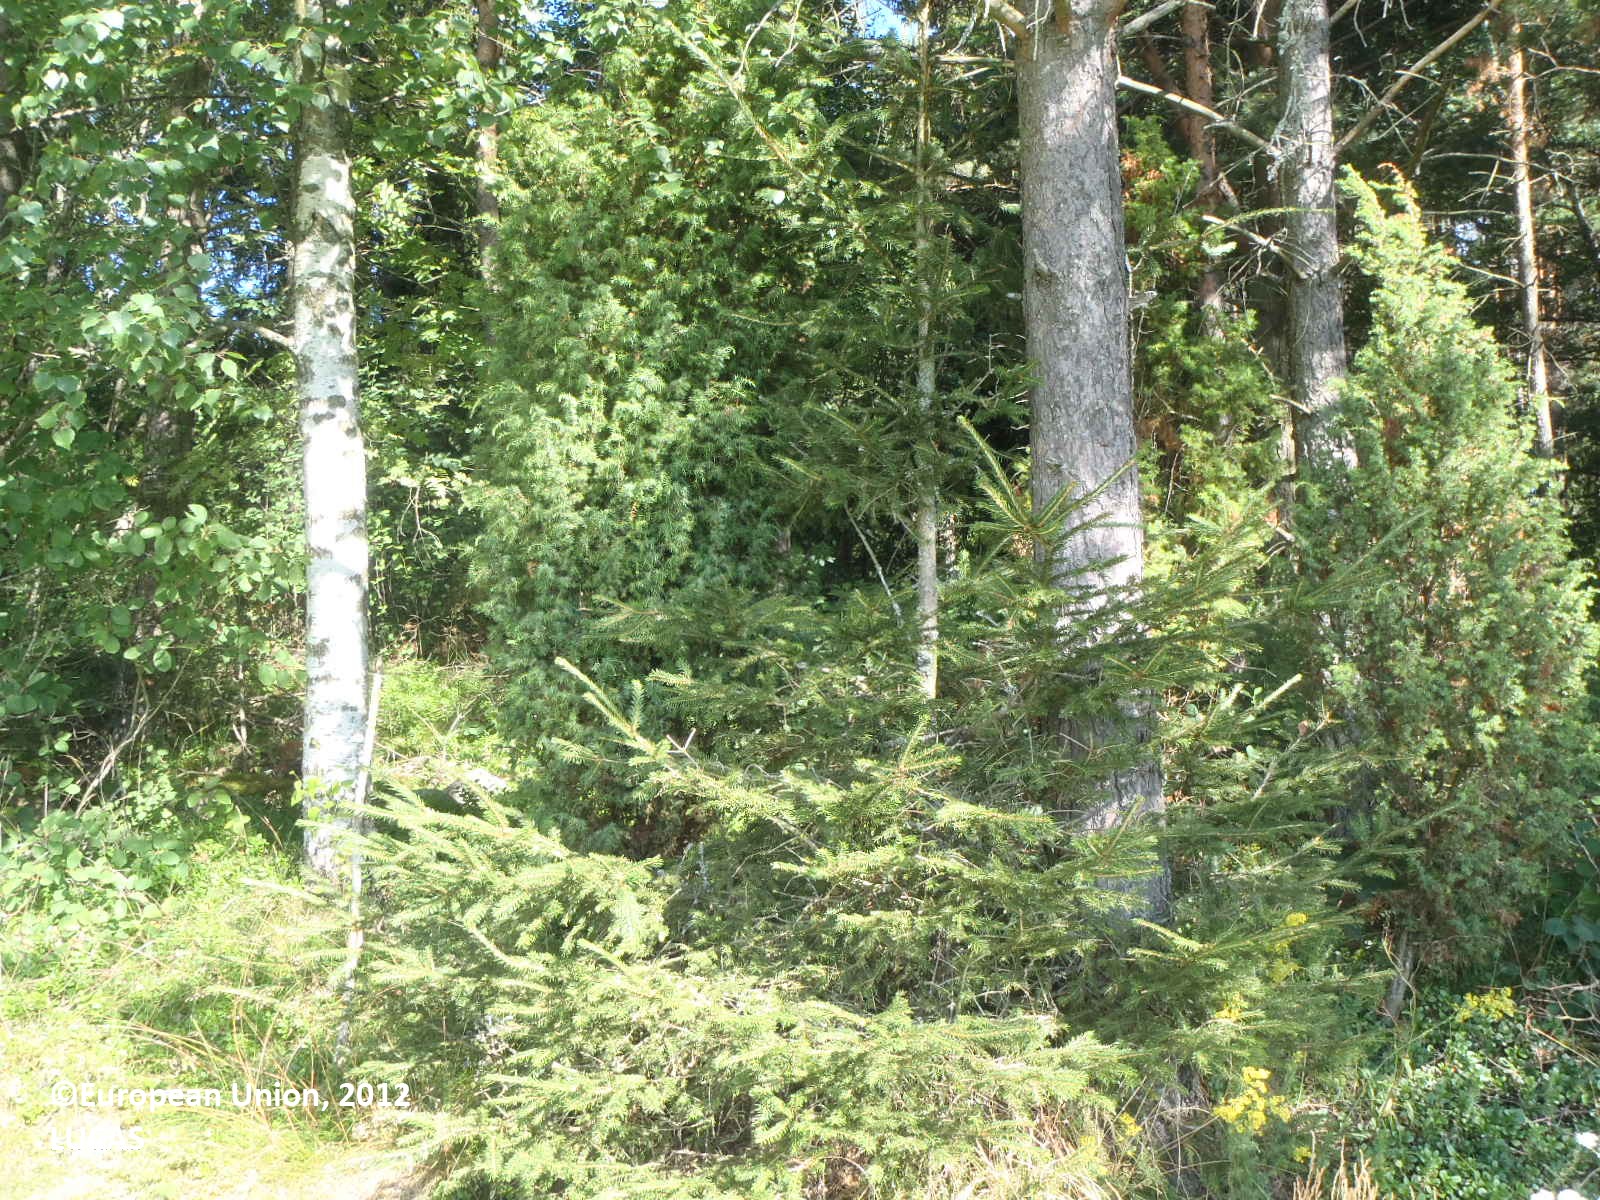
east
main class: Cropland
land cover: Rape and turnip rape
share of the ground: > 75 %
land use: Agriculture (excluding fallow land and kitchen gardens)
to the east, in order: Rape and turnip rape; Grass margins; Ditches and canals; Grass margins; Pine dominated mixed woodland; Grassland without tree/shrub cover; Paved roads, cycling and walking lanes; Pine dominated mixed woodland; Grassland without tree/shrub cover; Paved roads, cycling and walking lanes; Grass margins; Fences; Managed hedges; Grassland without tree/shrub cover; Artificial constructions in urban areas; Grass margins; Apple fruit; Fences
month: July
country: FI
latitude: 60.6452
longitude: 21.8556
